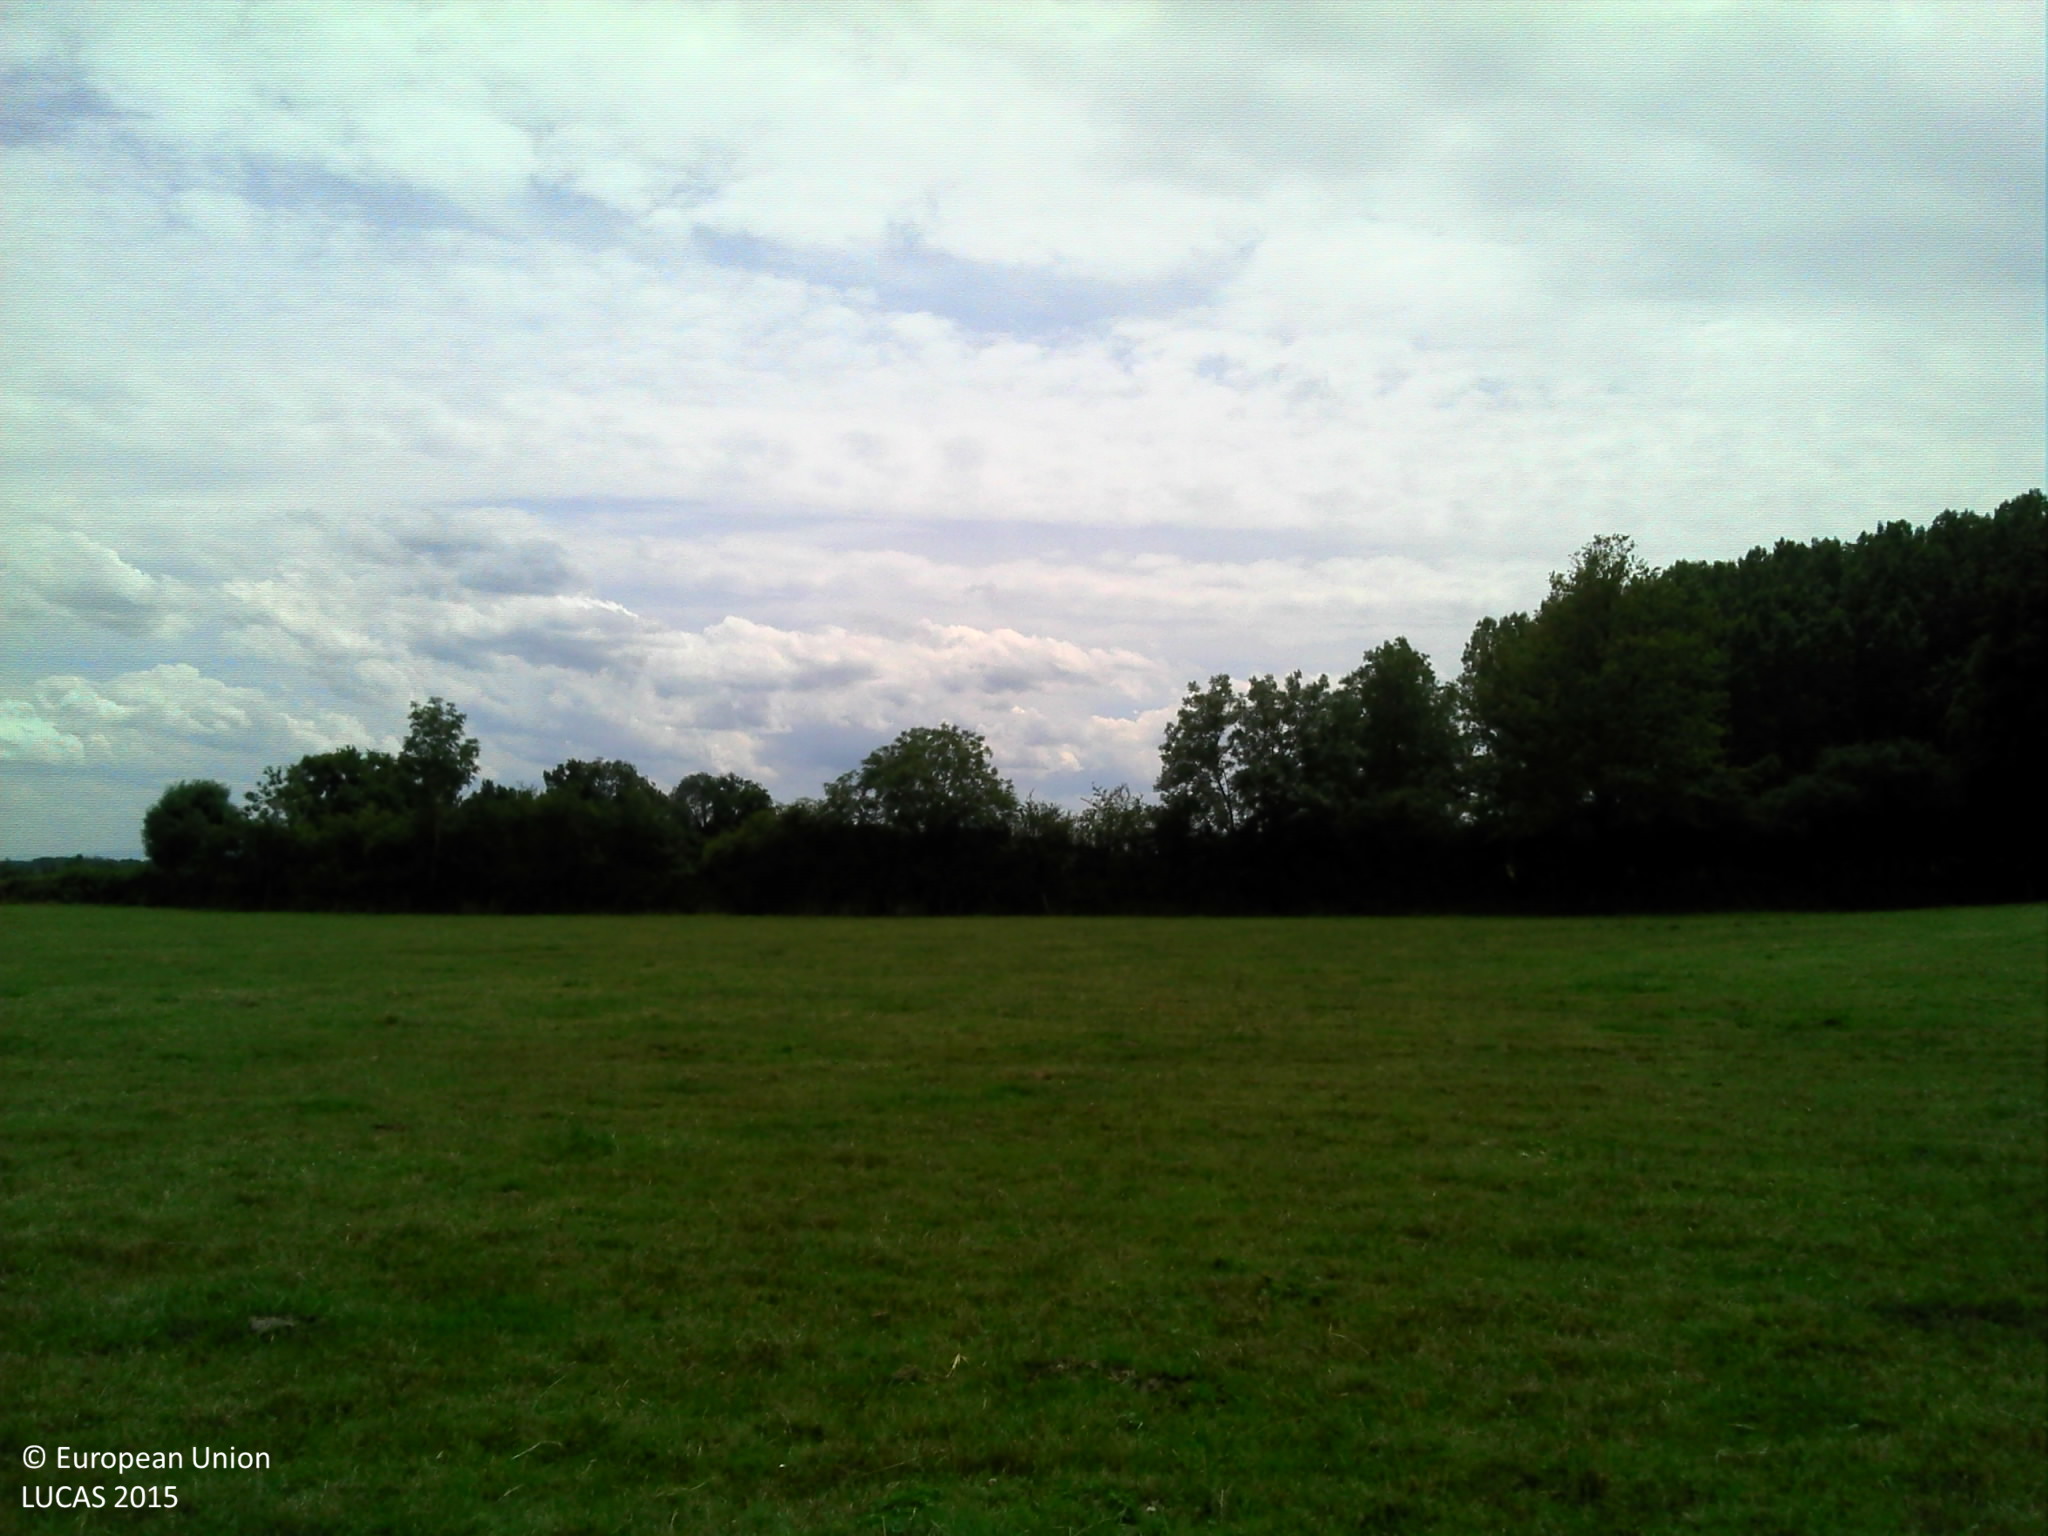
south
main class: Grassland
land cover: Grassland without tree/shrub cover
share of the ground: > 75 %
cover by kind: herbaceous plants 100 %
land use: Agriculture (excluding fallow land and kitchen gardens)
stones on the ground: < 10 %
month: June
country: FR
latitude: 46.4495
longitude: 3.3201
